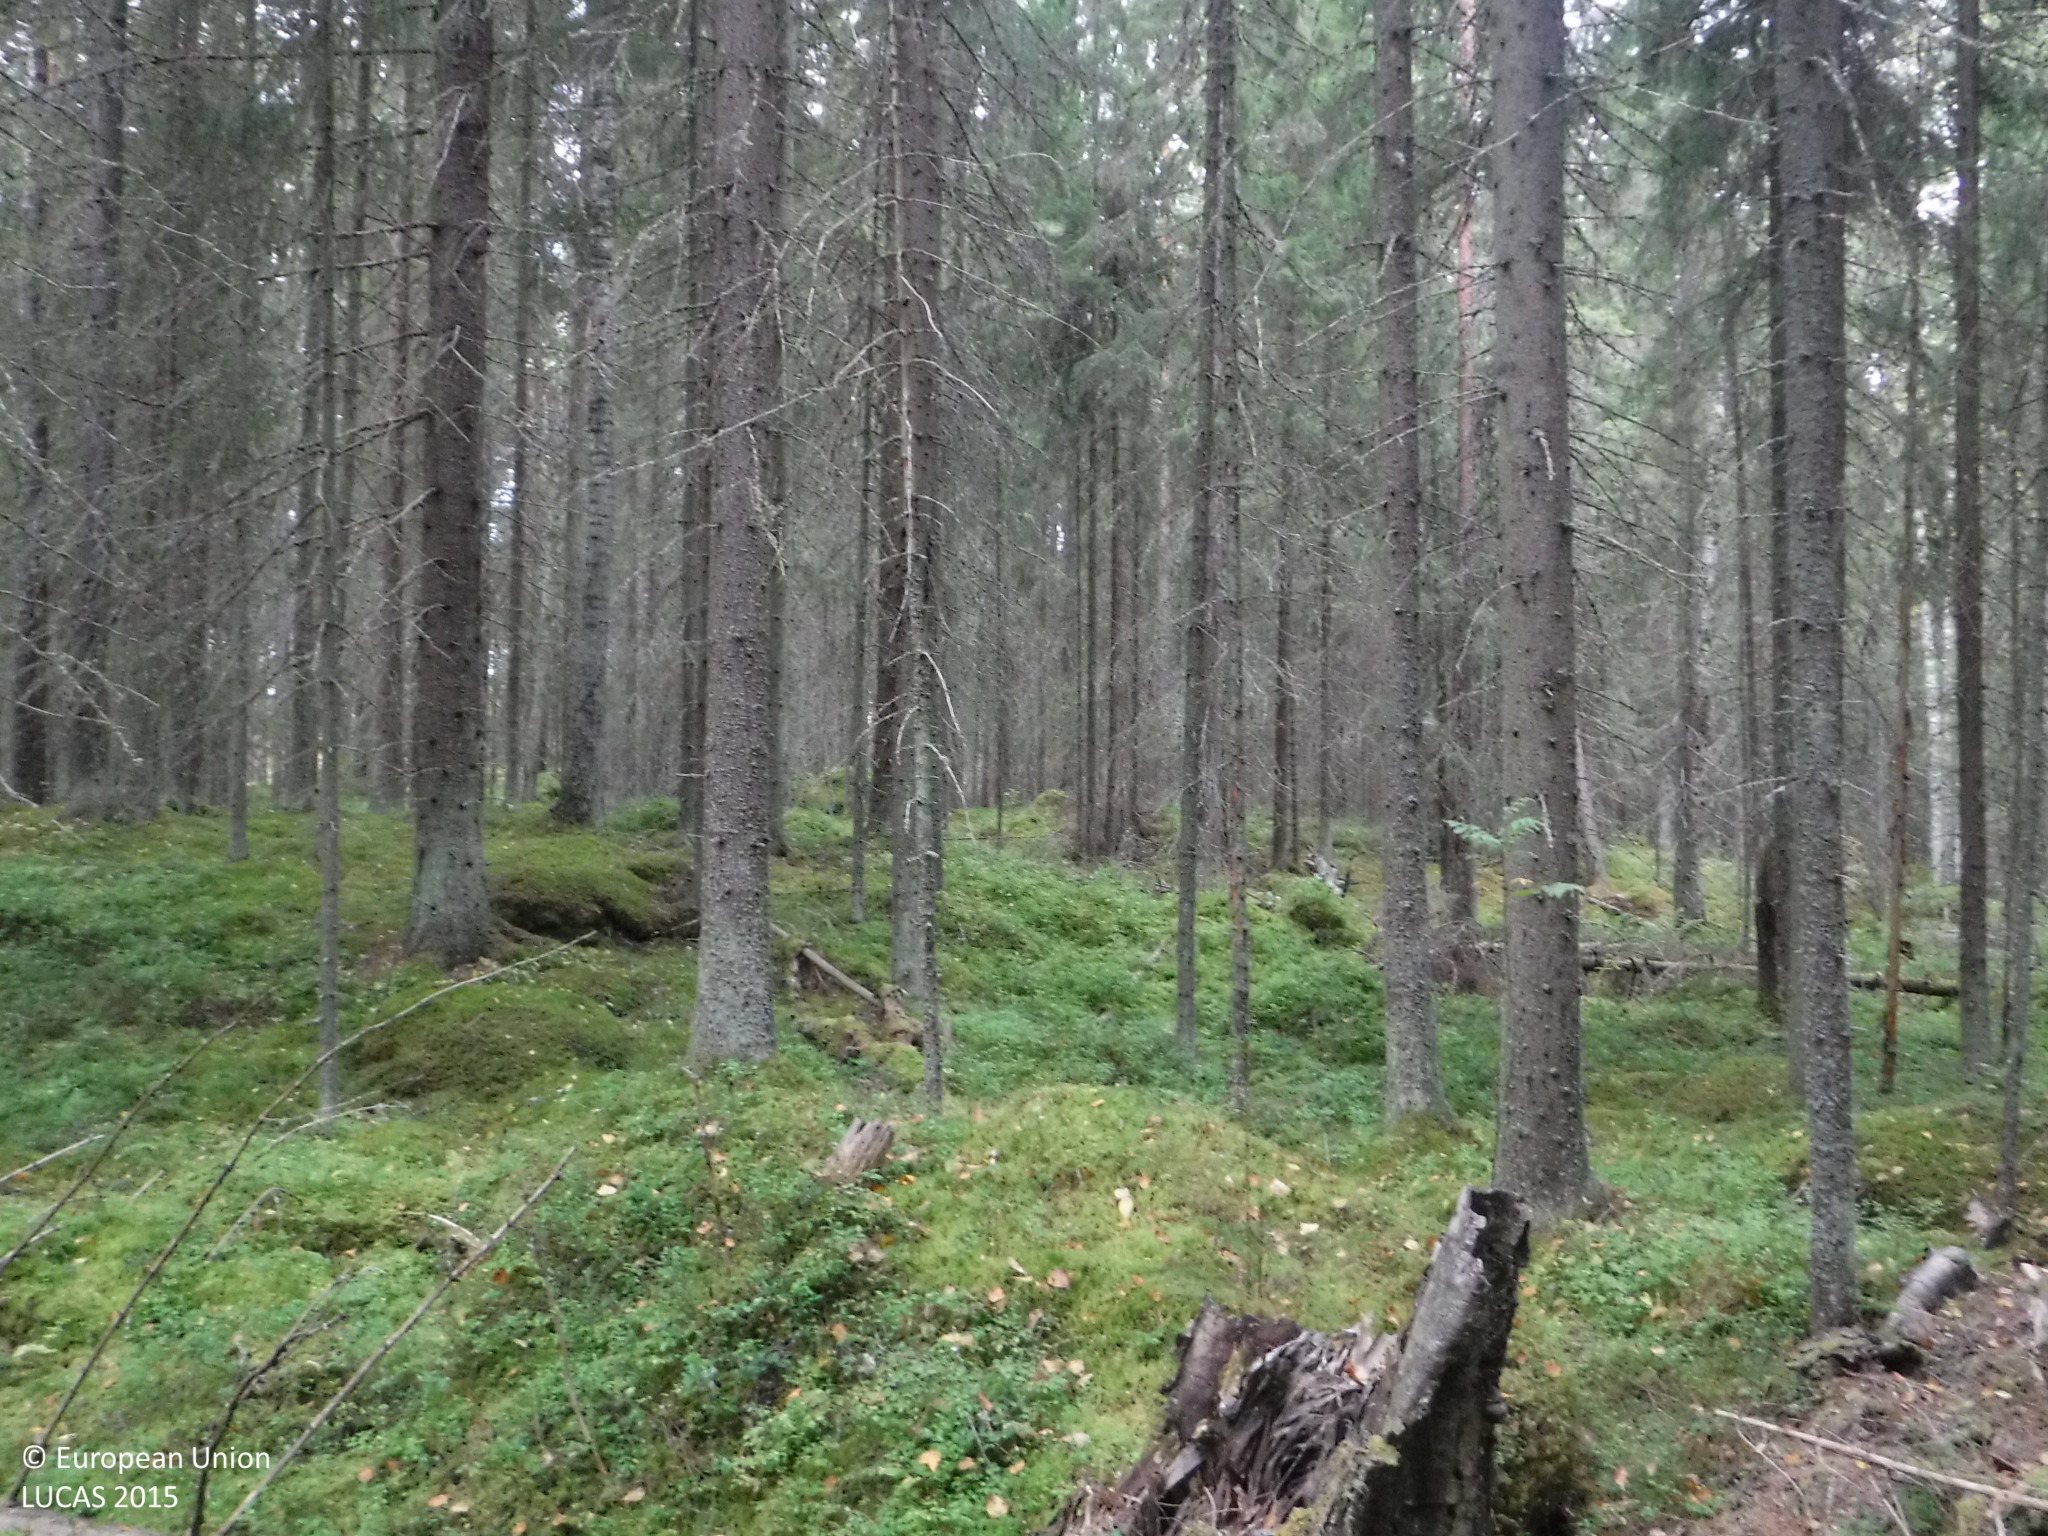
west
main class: Woodland
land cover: Spruce dominated coniferous woodland
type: boreal forest
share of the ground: 50 - 75 %
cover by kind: coniferous forest trees 65 %, lichens and mosses 25 %, shrubs 10 %
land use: Forestry
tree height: > 5 m
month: September
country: FI
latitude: 61.7404
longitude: 22.0783
